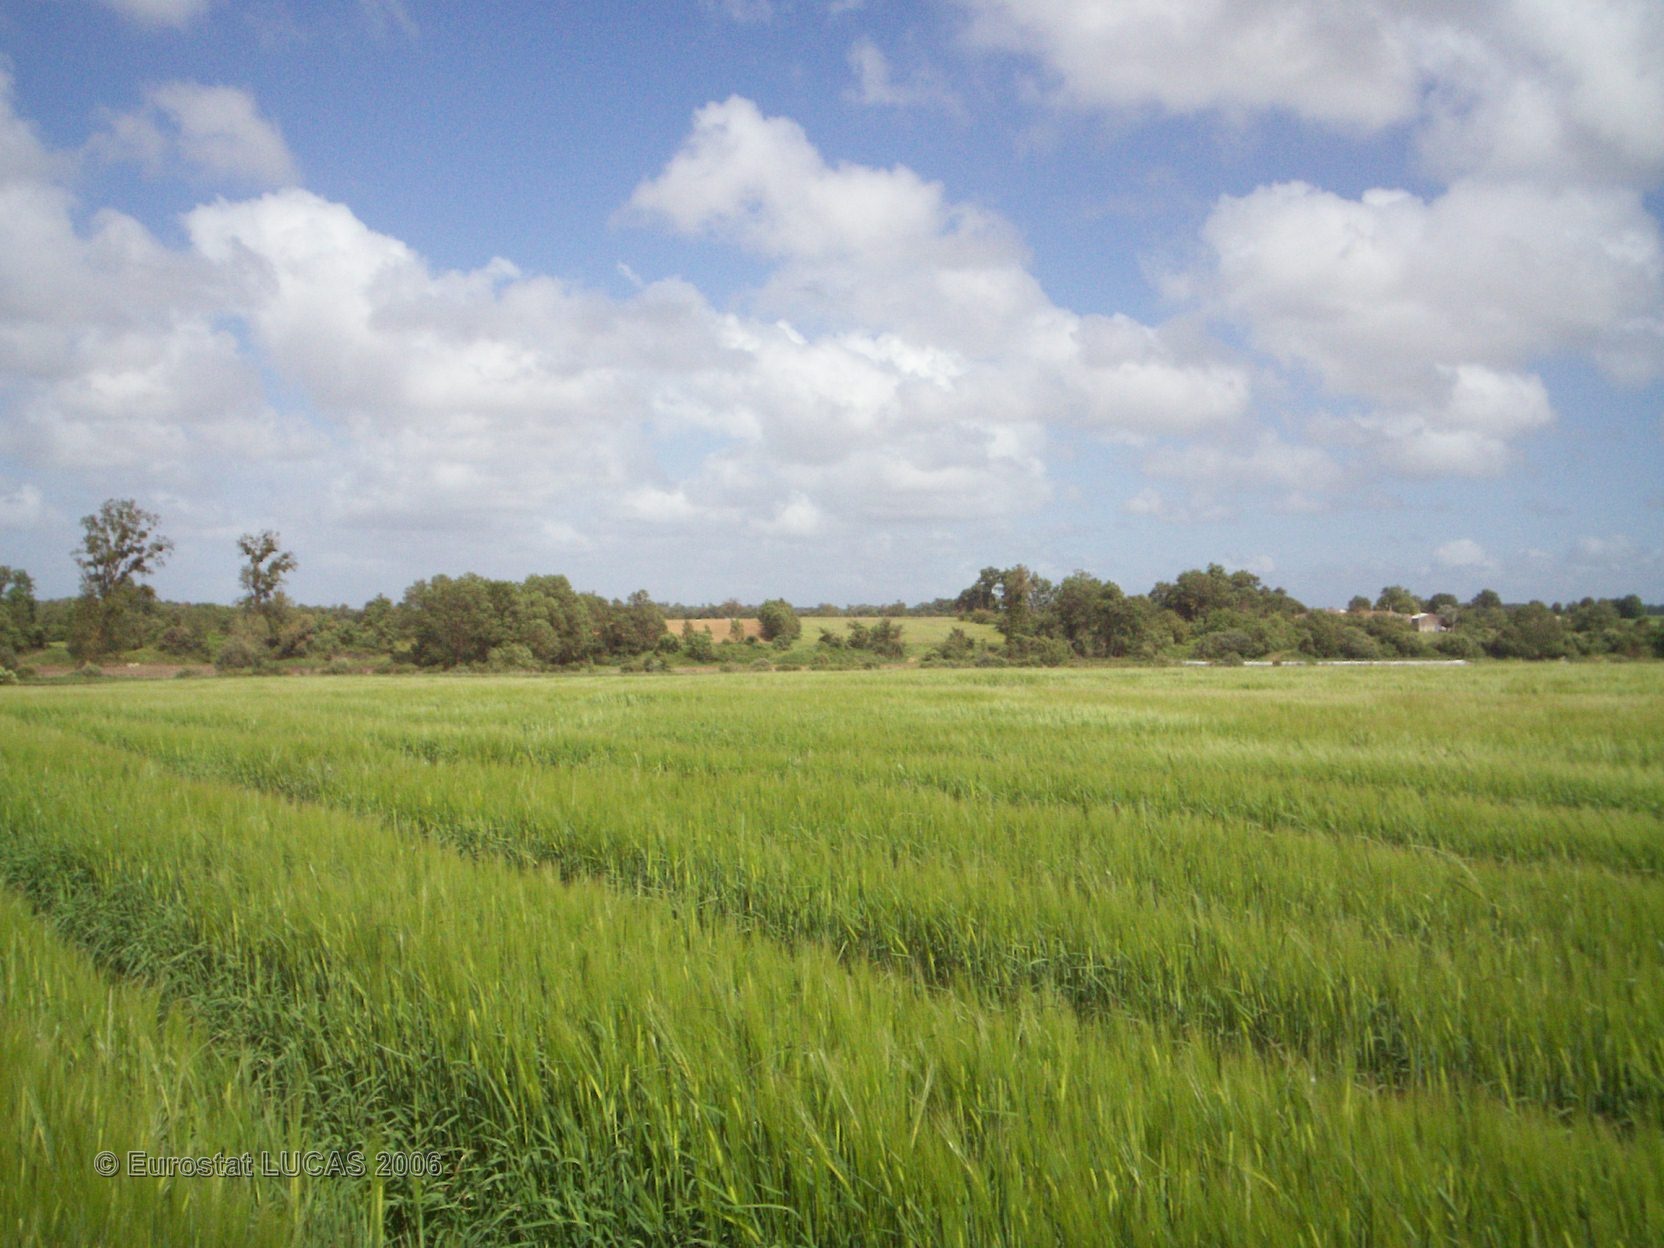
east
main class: Cropland
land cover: Barley
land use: Agriculture (excluding fallow land and kitchen gardens)
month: May
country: FR
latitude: 45.7497
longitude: -0.7850
